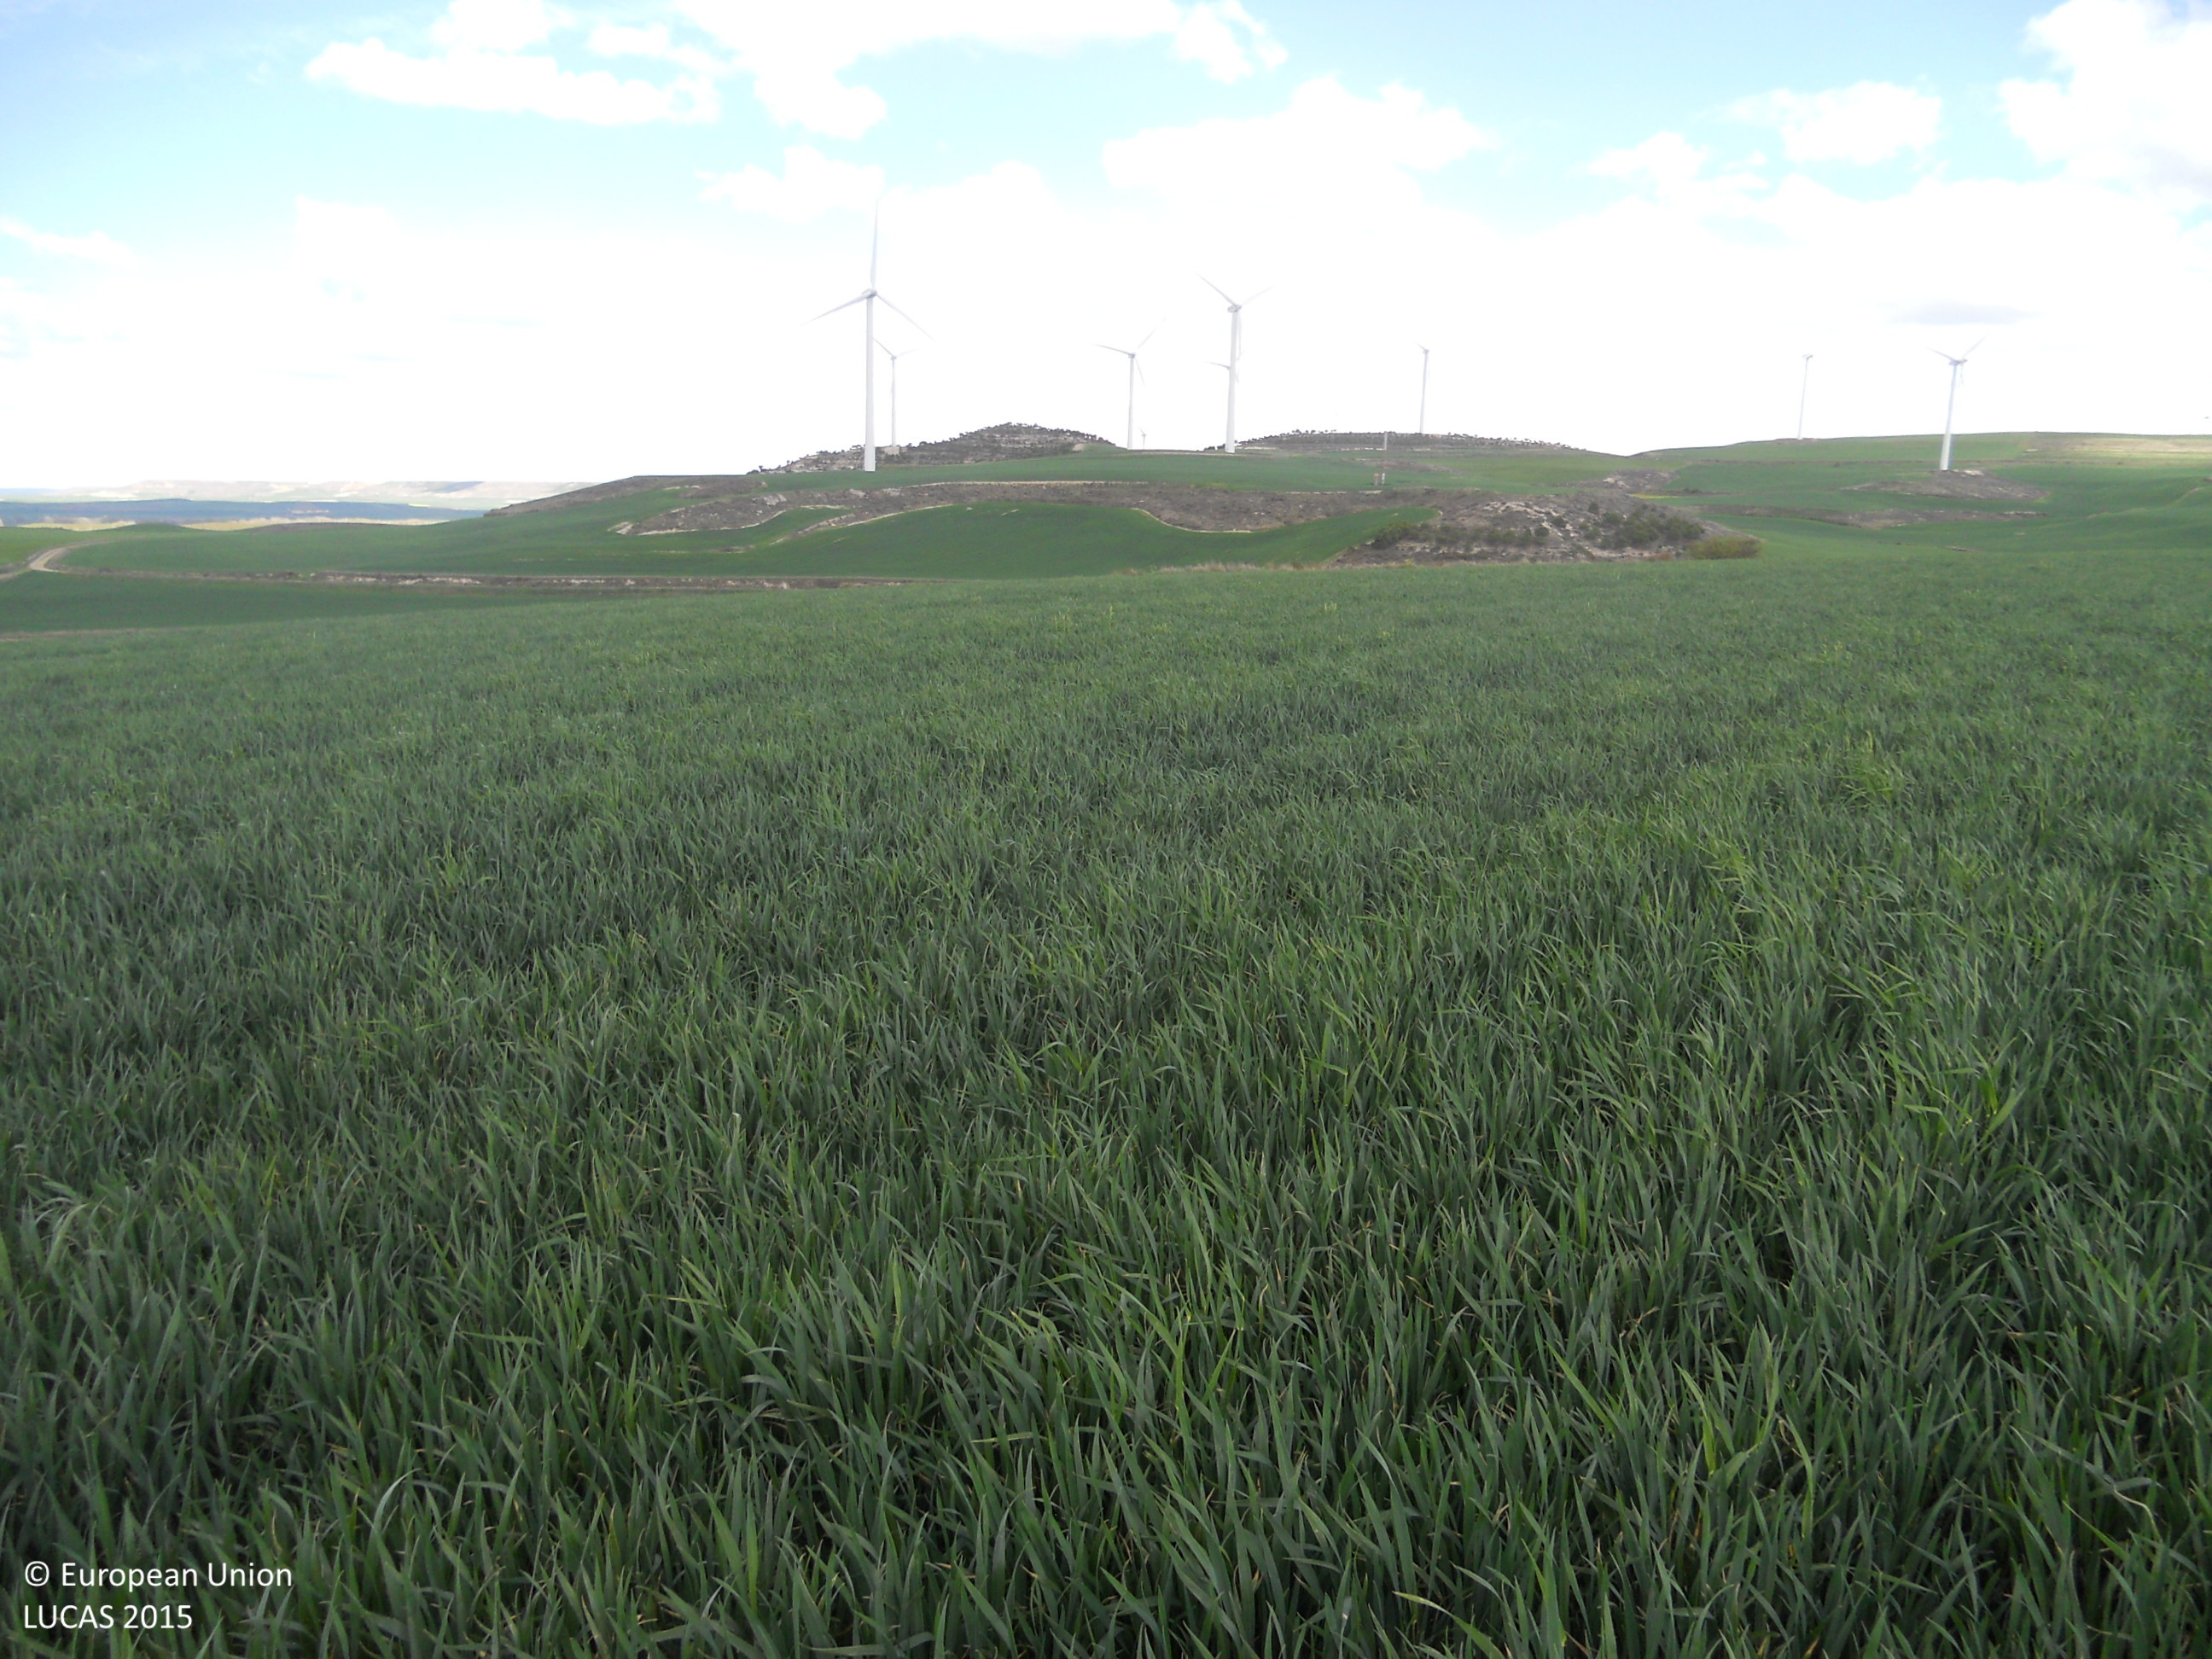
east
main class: Cropland
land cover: Barley
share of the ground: > 75 %
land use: Agriculture (excluding fallow land and kitchen gardens)
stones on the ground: < 10 %
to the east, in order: Barley; Grass margins; Barley; Common wheat
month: April
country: ES
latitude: 42.2400
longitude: -4.2836
